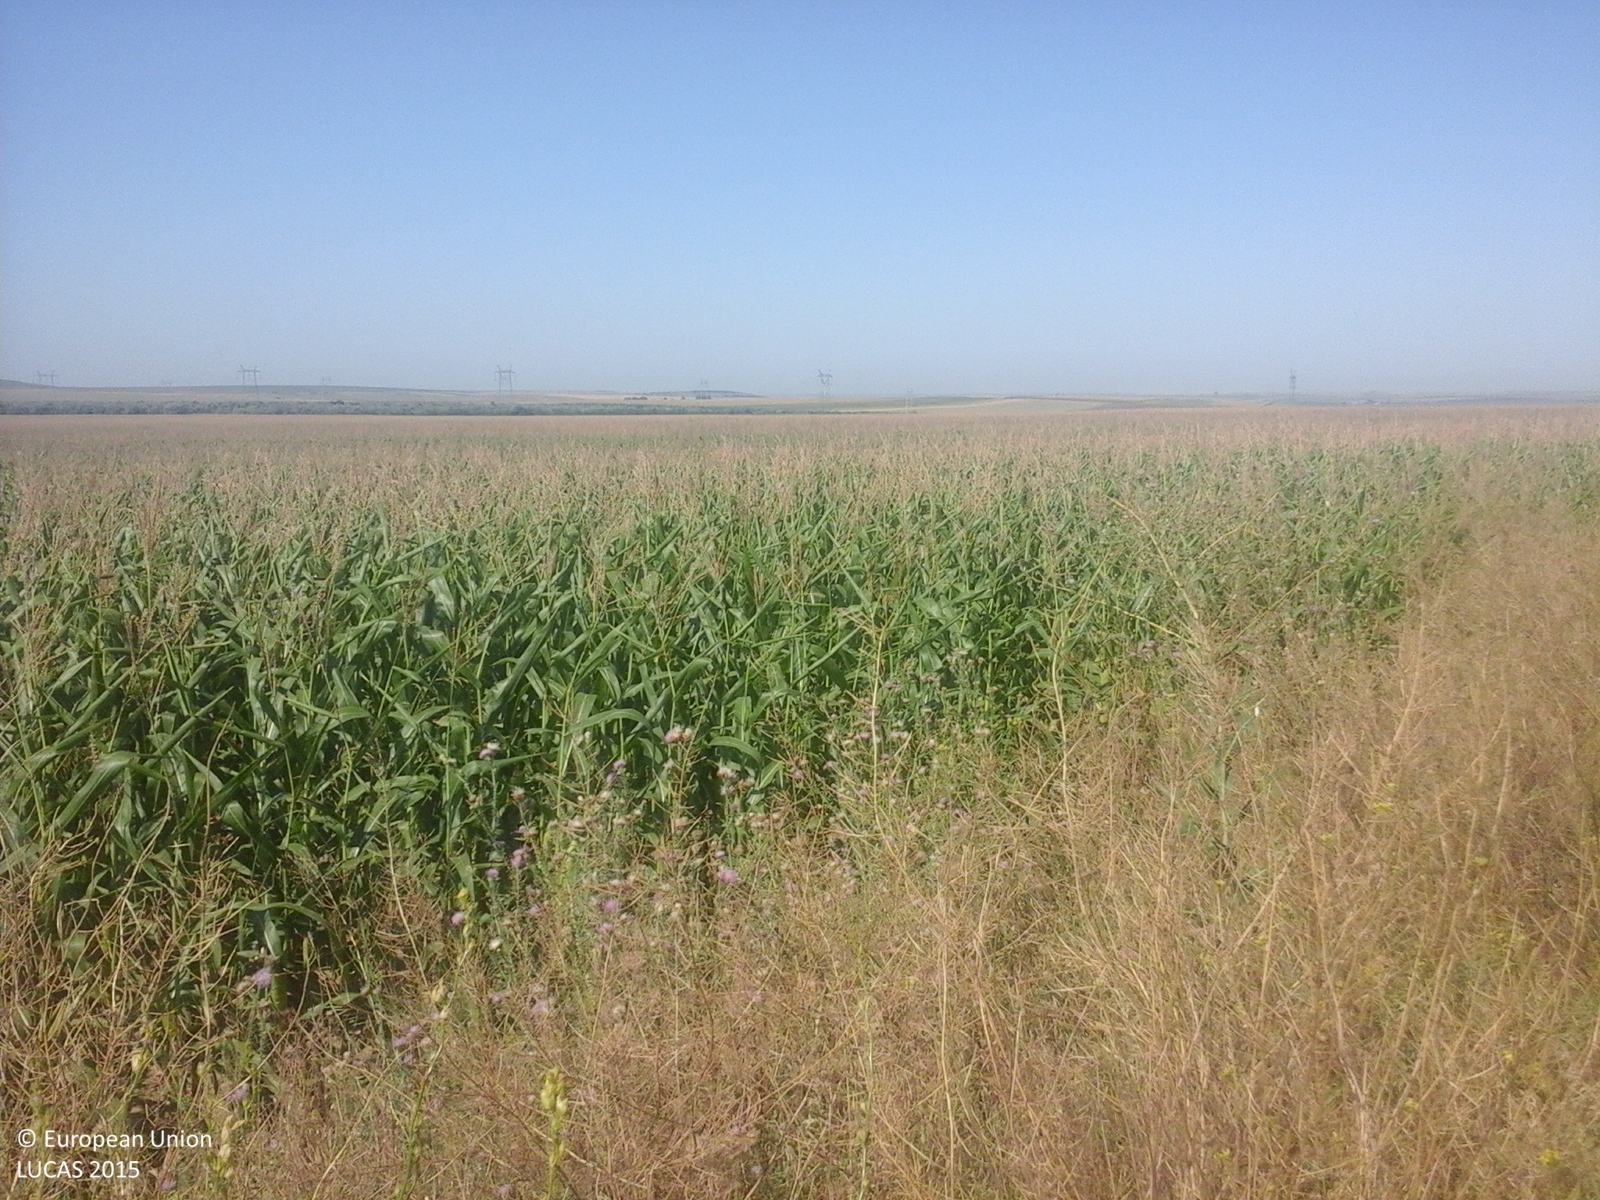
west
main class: Cropland
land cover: Maize
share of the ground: > 75 %
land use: Agriculture (excluding fallow land and kitchen gardens)
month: August
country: RO
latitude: 44.6203
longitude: 28.2263
